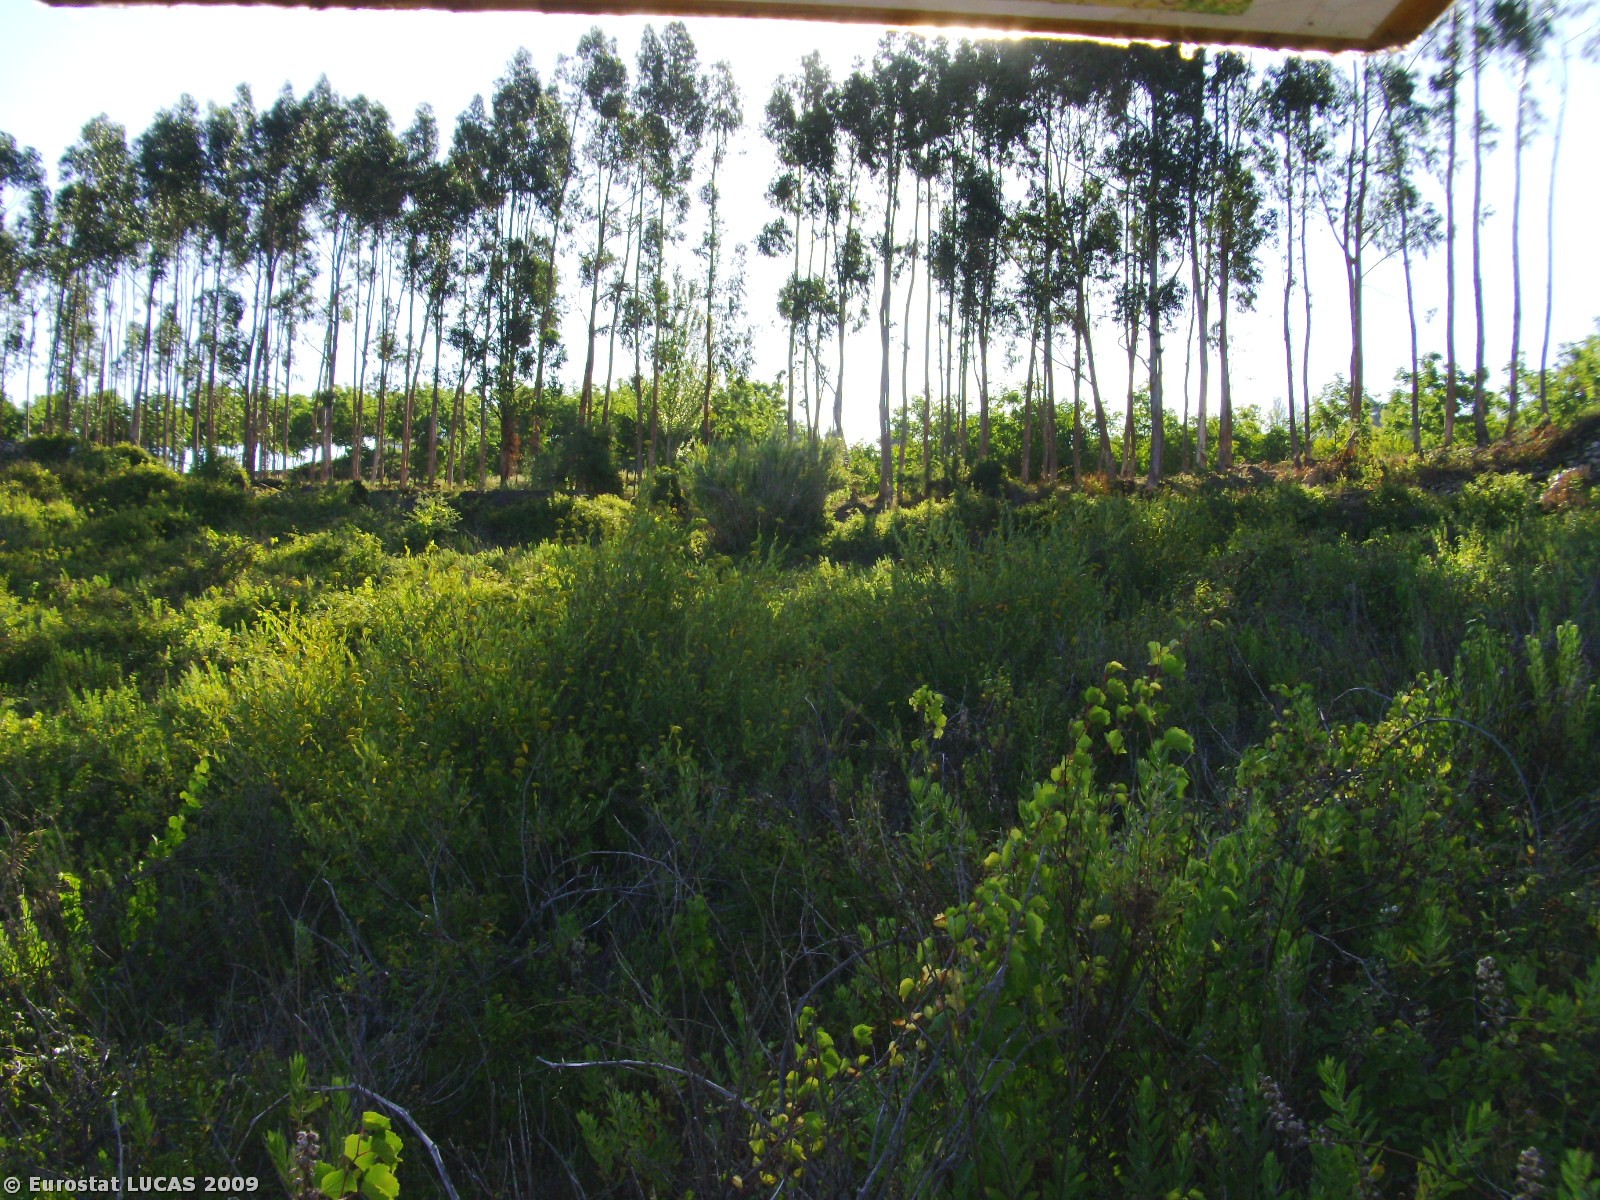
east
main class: Cropland
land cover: Vineyards
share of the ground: 25 - 50 %
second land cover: Shrubland without tree cover
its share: 50 - 75 %
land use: Fallow land
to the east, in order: Vineyards; Shrubland without tree cover; Vineyards; Shrubland with sparse tree cover; Tracks; Grass margins; Dry stone walls; Tracks; Dry stone walls; Broadleaved woodland; Olive groves; Paved roads, cycling and walking lanes; Broadleaved woodland; Shrubland with sparse tree cover; Temporary grasslands
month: July
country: PT
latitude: 38.9802
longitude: -9.0198
